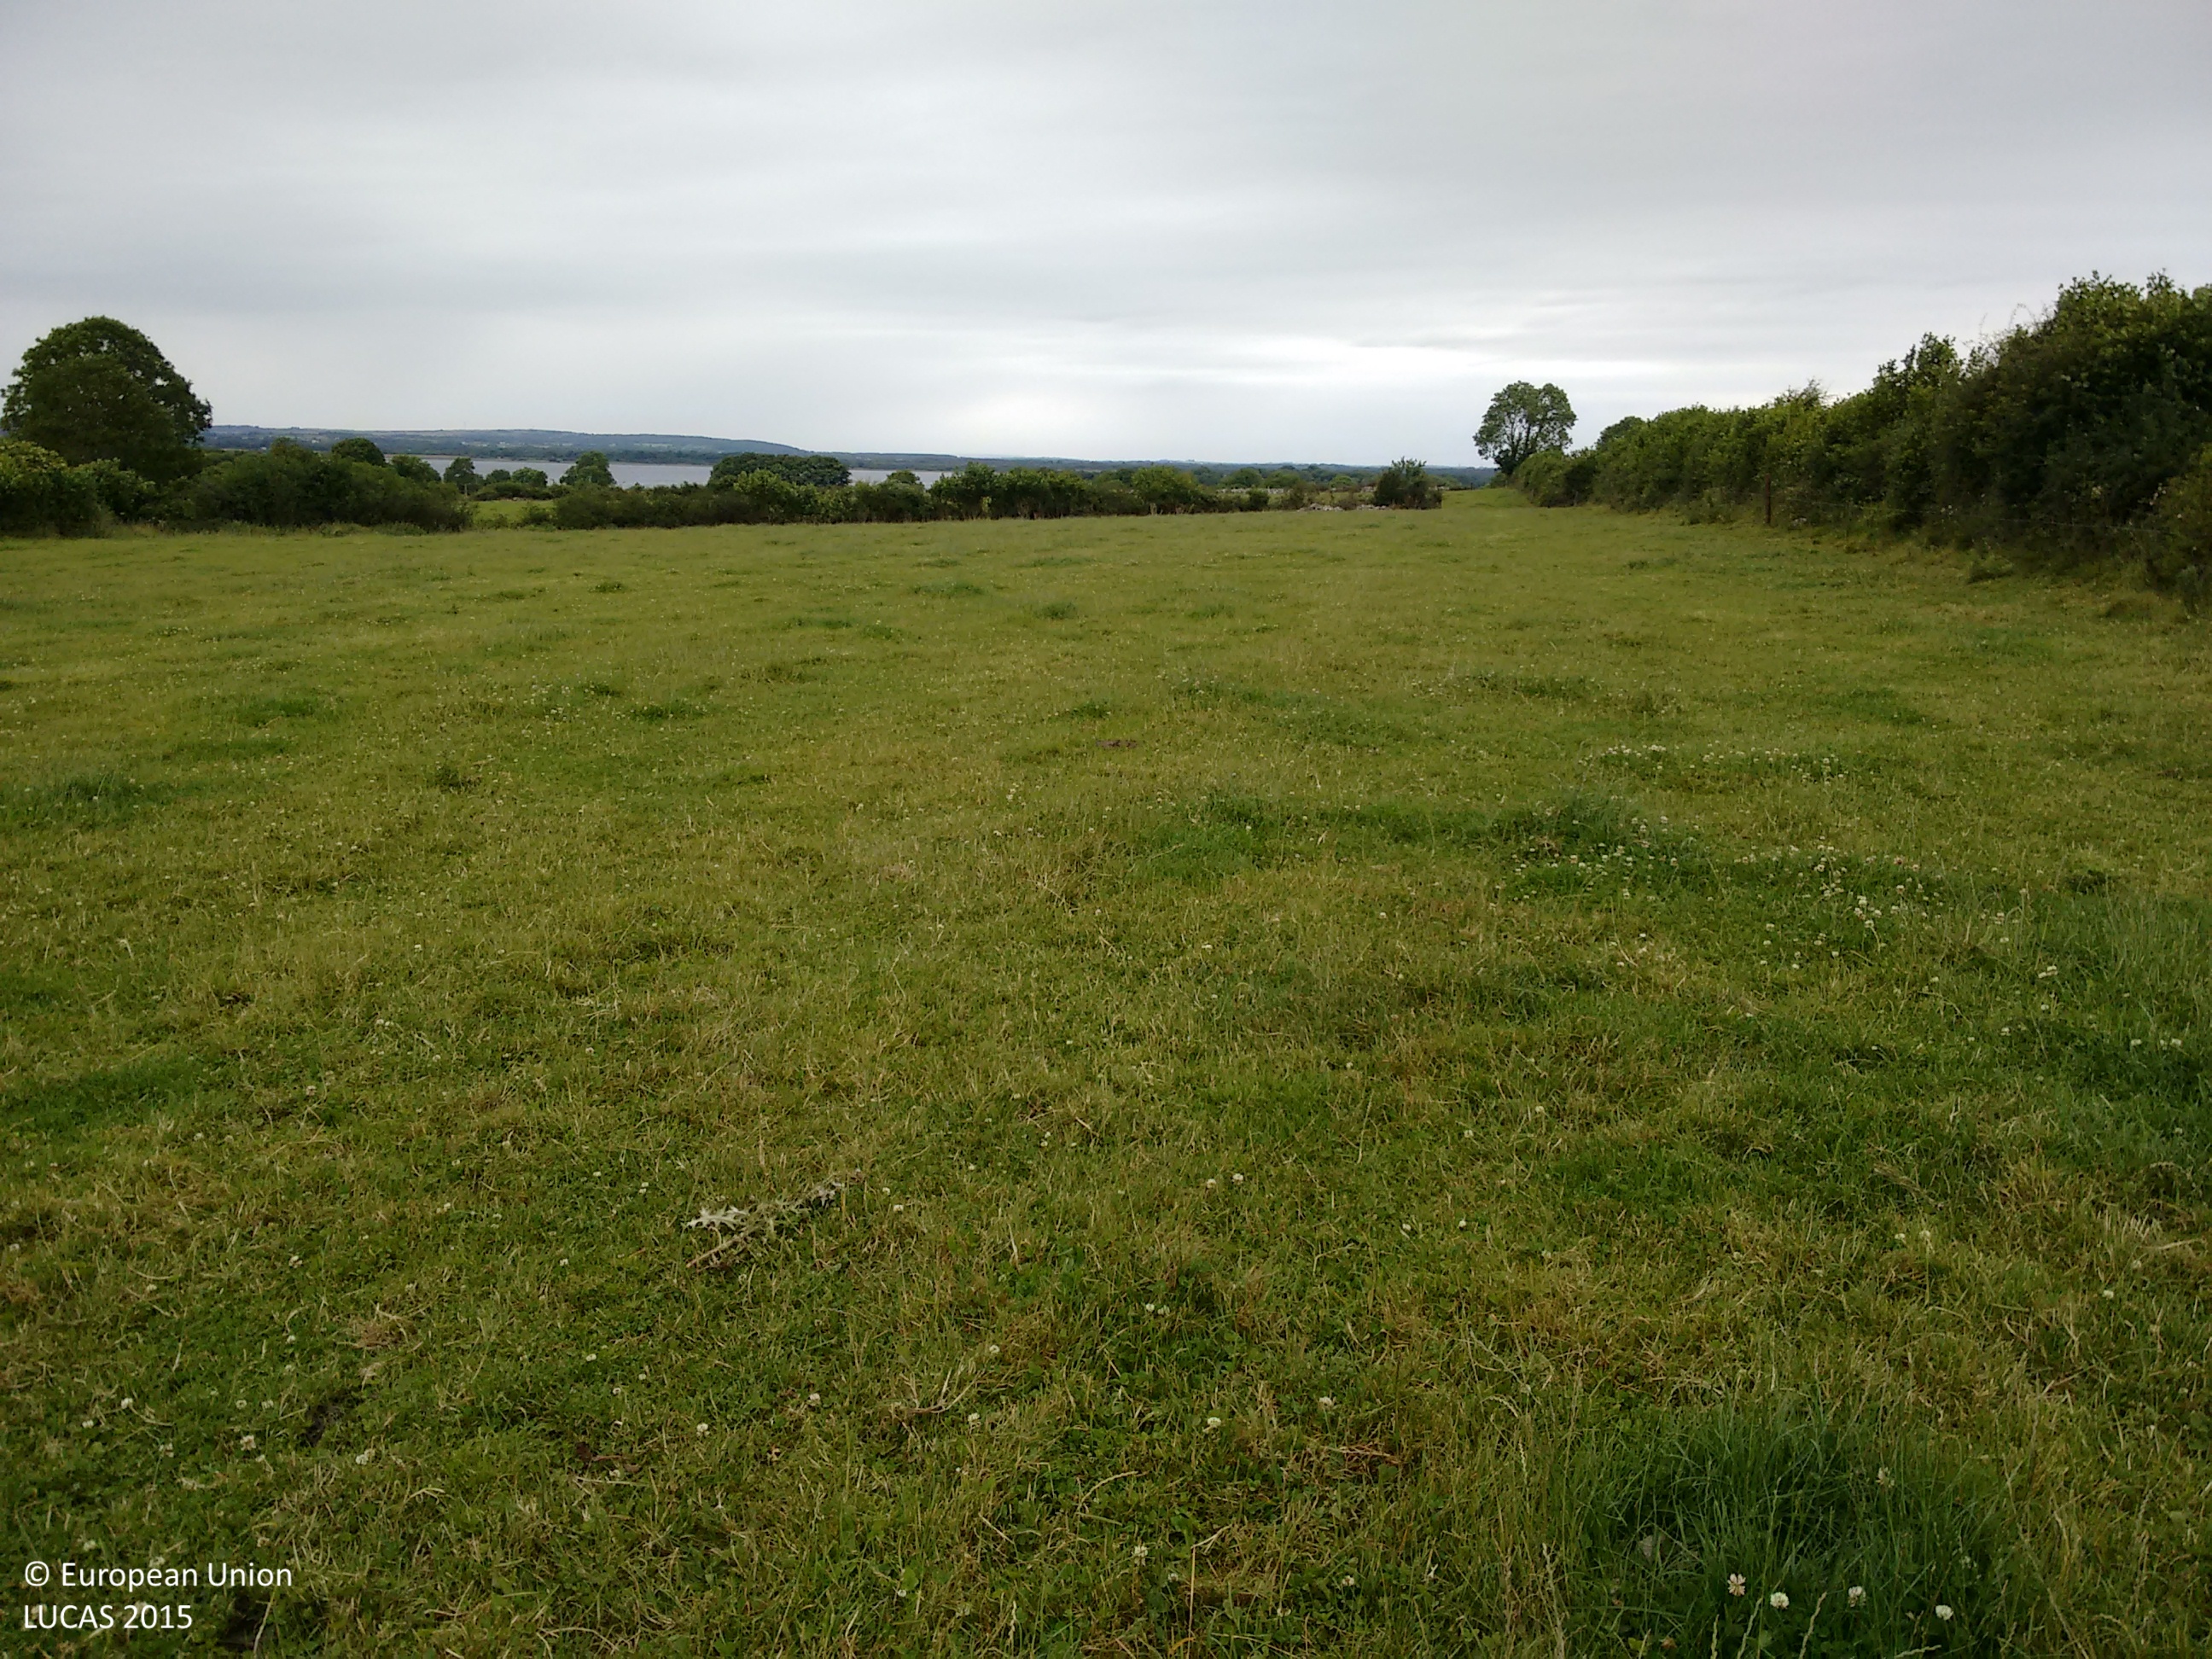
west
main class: Grassland
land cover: Grassland without tree/shrub cover
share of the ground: > 75 %
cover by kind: herbaceous plants 100 %
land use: Agriculture (excluding fallow land and kitchen gardens)
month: July
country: IE
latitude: 53.6234
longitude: -8.0008
